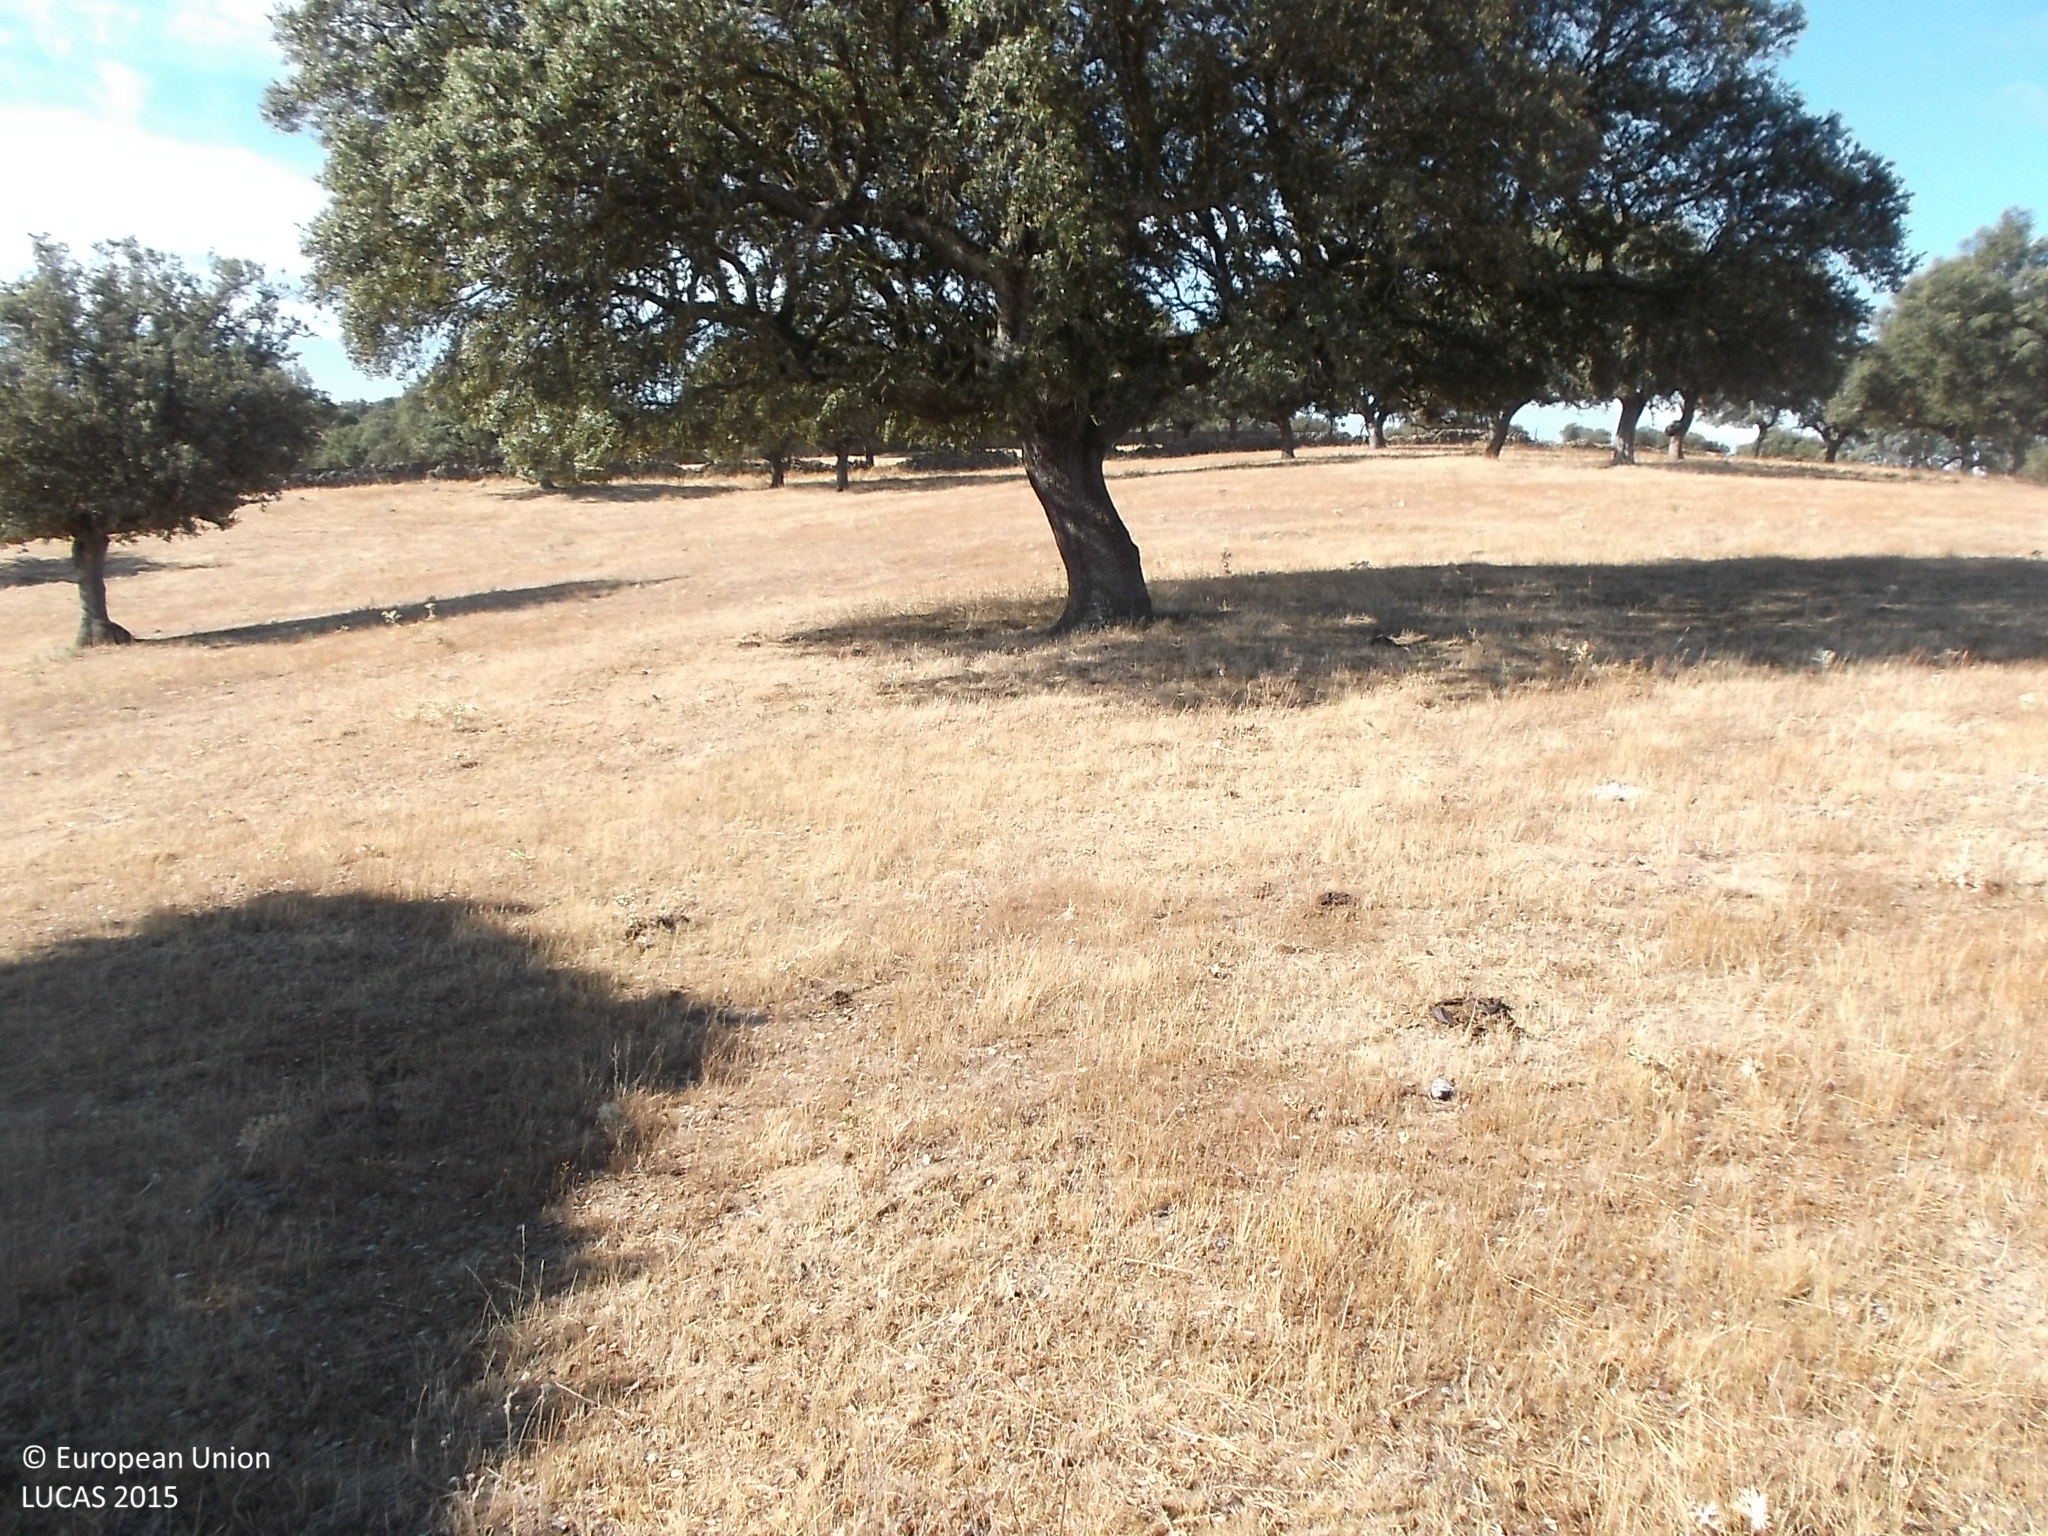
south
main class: Woodland
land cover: Broadleaved woodland
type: broadleaved evergreen forest
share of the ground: 10 - 25 %
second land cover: Grassland without tree/shrub cover
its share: > 75 %
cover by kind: herbaceous plants 85 %, broadleaved forest trees 15 %
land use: Forestry
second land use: Agriculture (excluding fallow land and kitchen gardens)
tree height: < 5 m
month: July
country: ES
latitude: 40.8837
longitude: -6.2882
